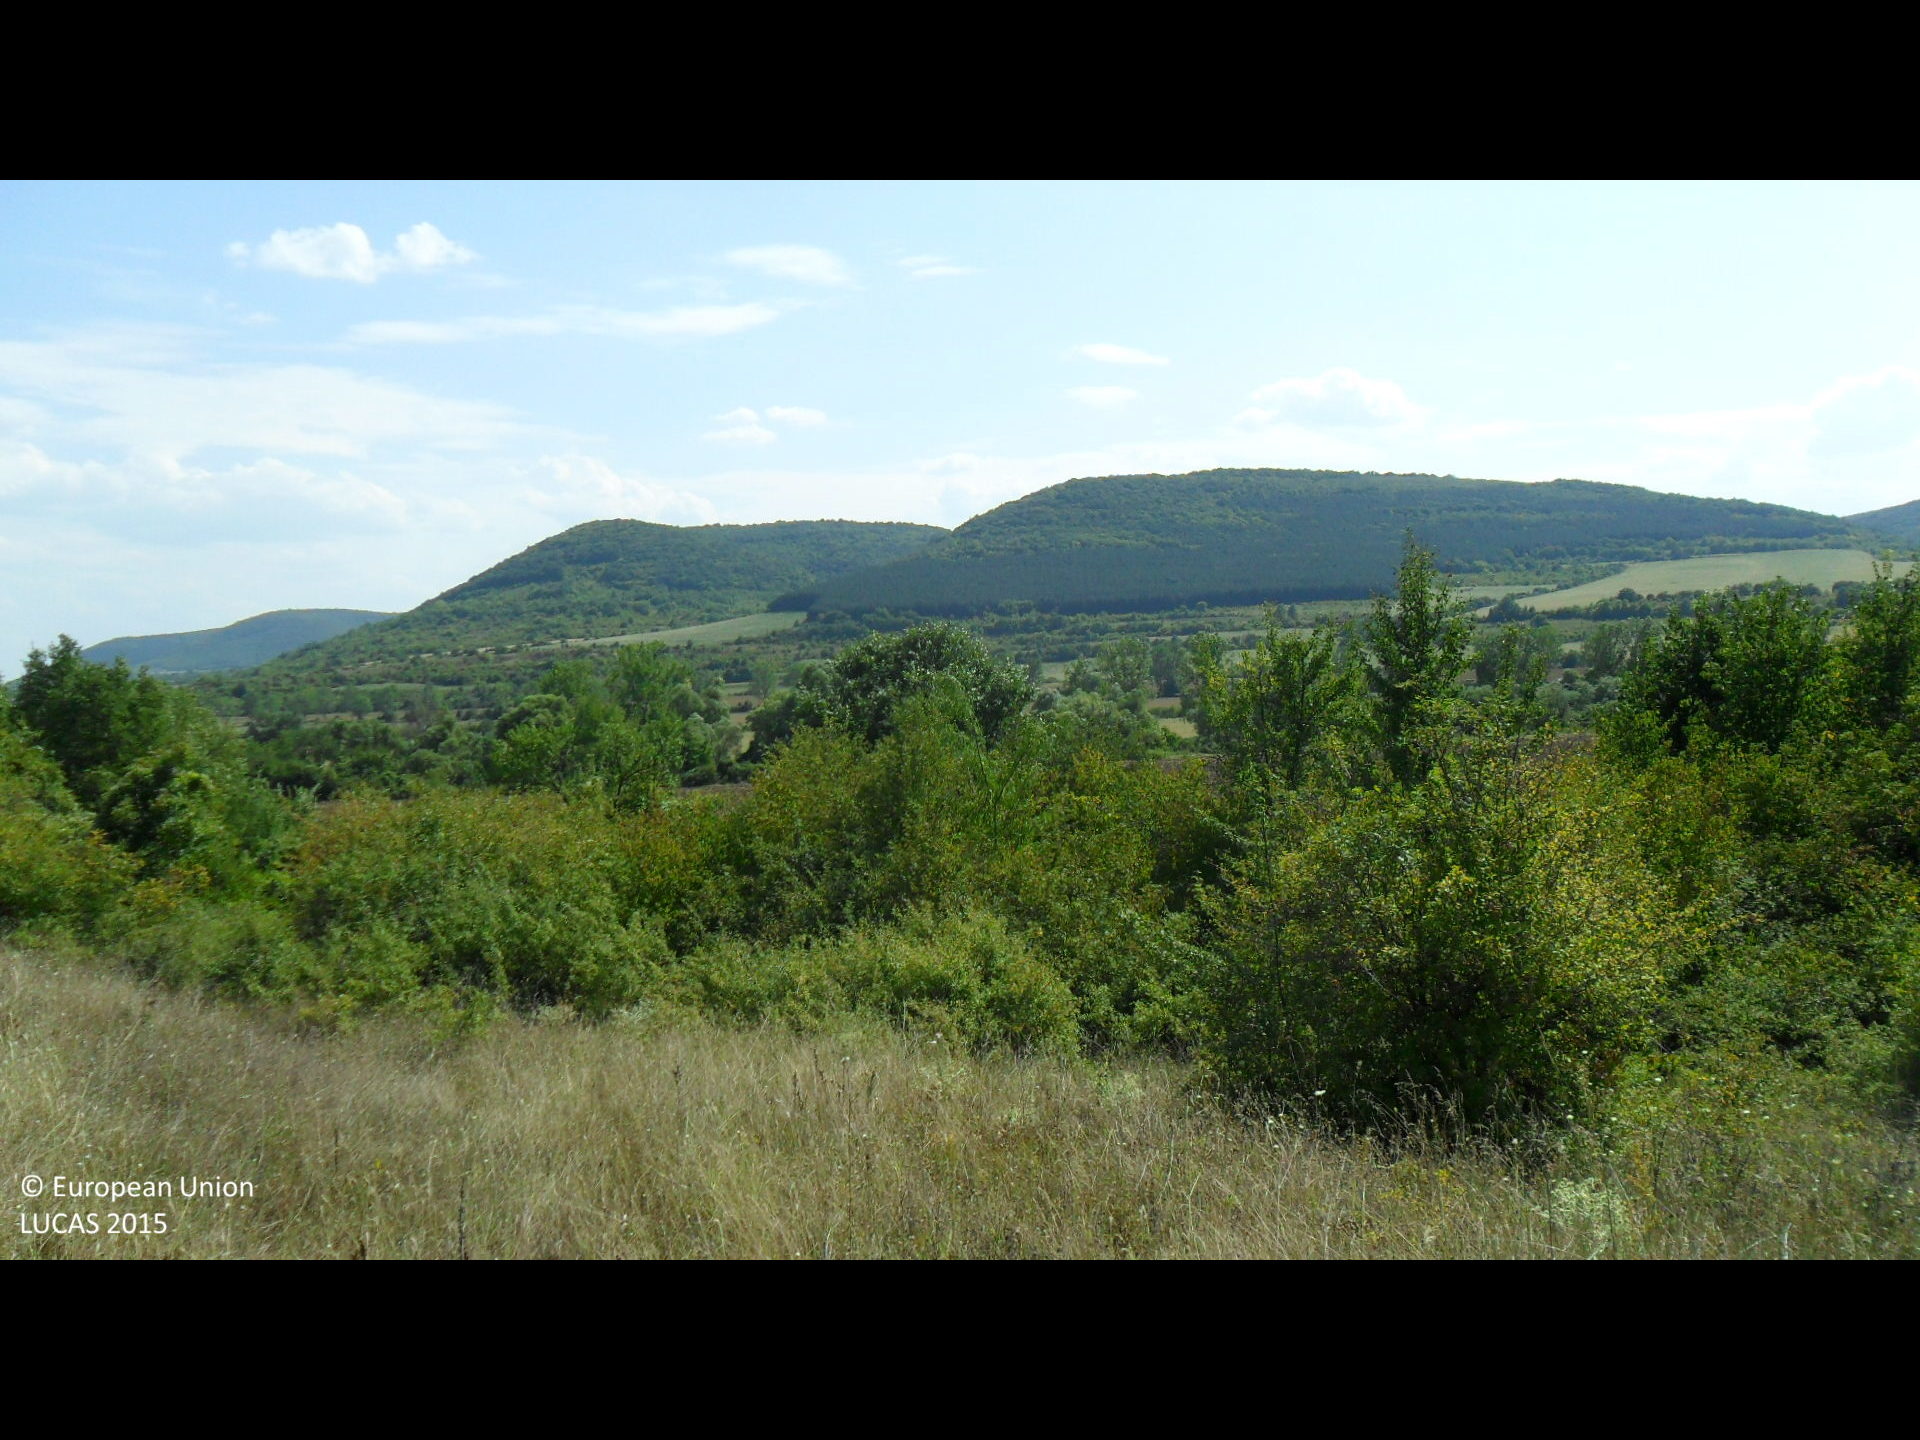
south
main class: Grassland
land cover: Grassland with sparse tree/shrub cover
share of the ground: > 75 %
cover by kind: herbaceous plants 90 %, broadleaved forest trees 5 %, shrubs 5 %
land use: Agriculture (excluding fallow land and kitchen gardens)
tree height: < 5 m
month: August
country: BG
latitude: 43.4785
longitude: 26.1557
